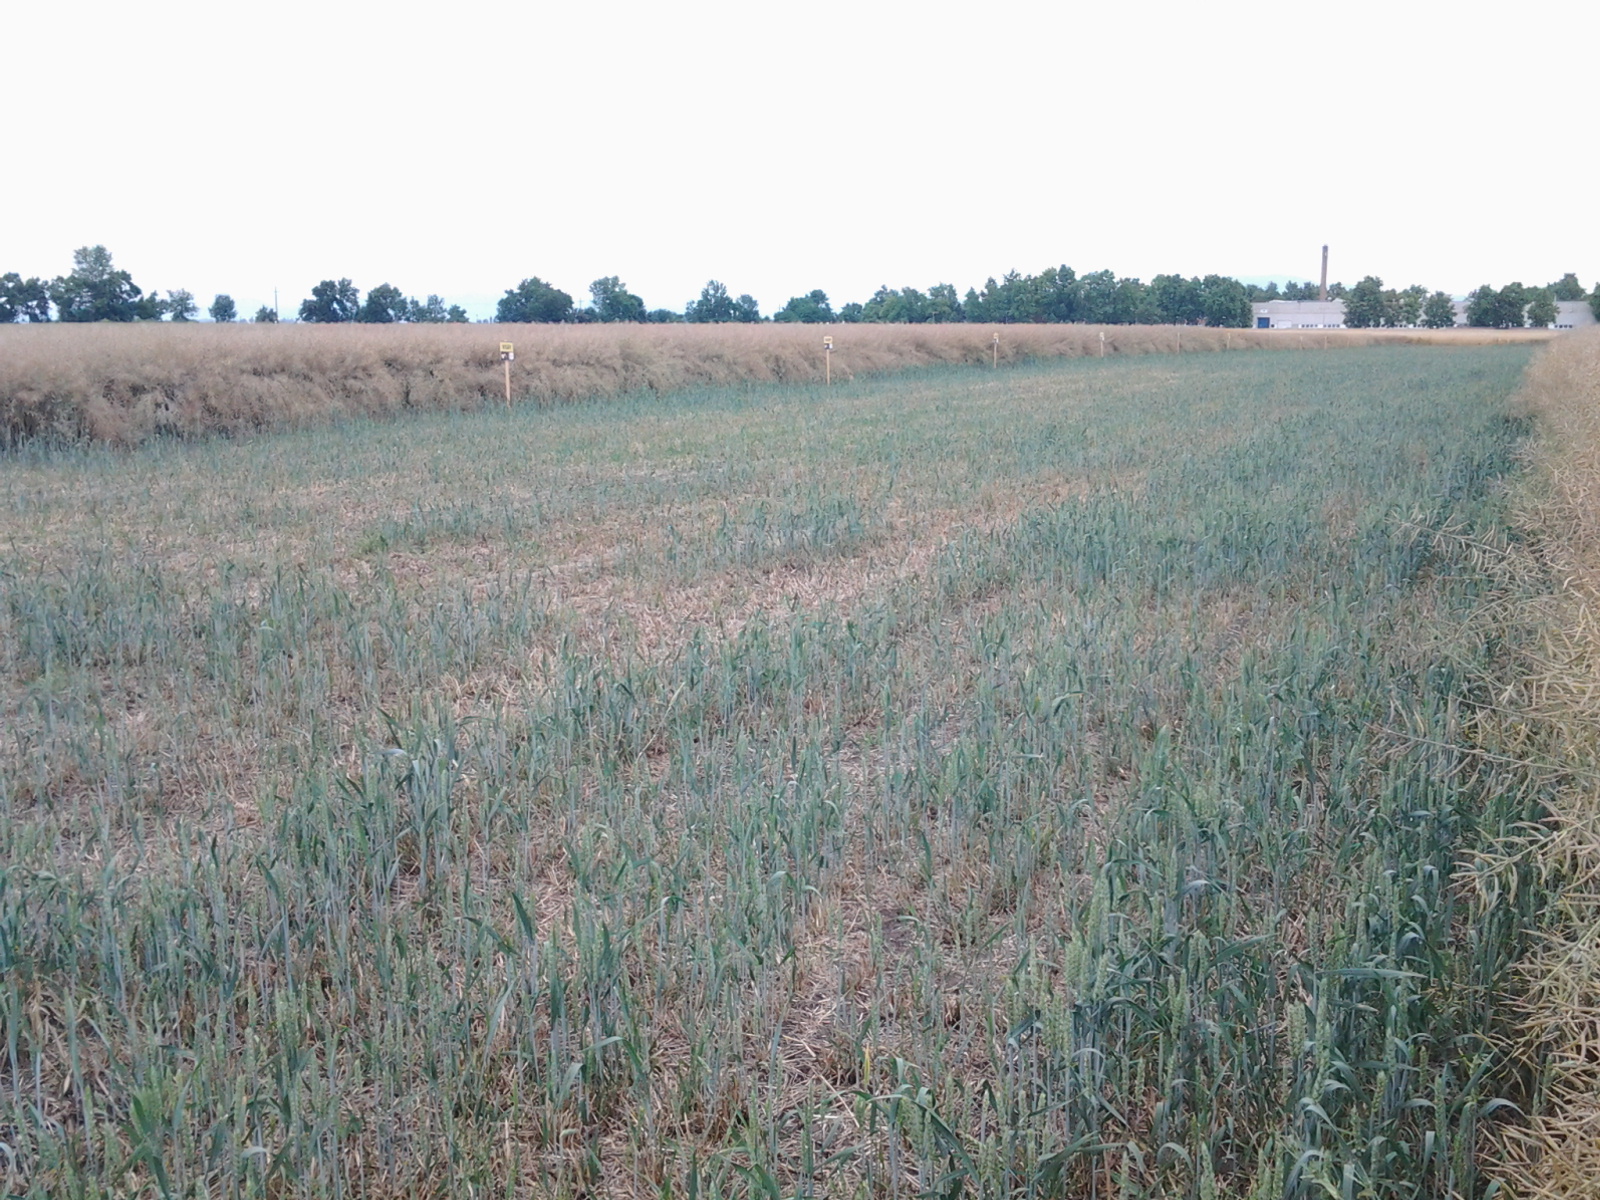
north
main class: Cropland
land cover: Rape and turnip rape
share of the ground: > 75 %
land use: Agriculture (excluding fallow land and kitchen gardens)
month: June
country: HU
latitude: 47.6258
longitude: 19.9664
